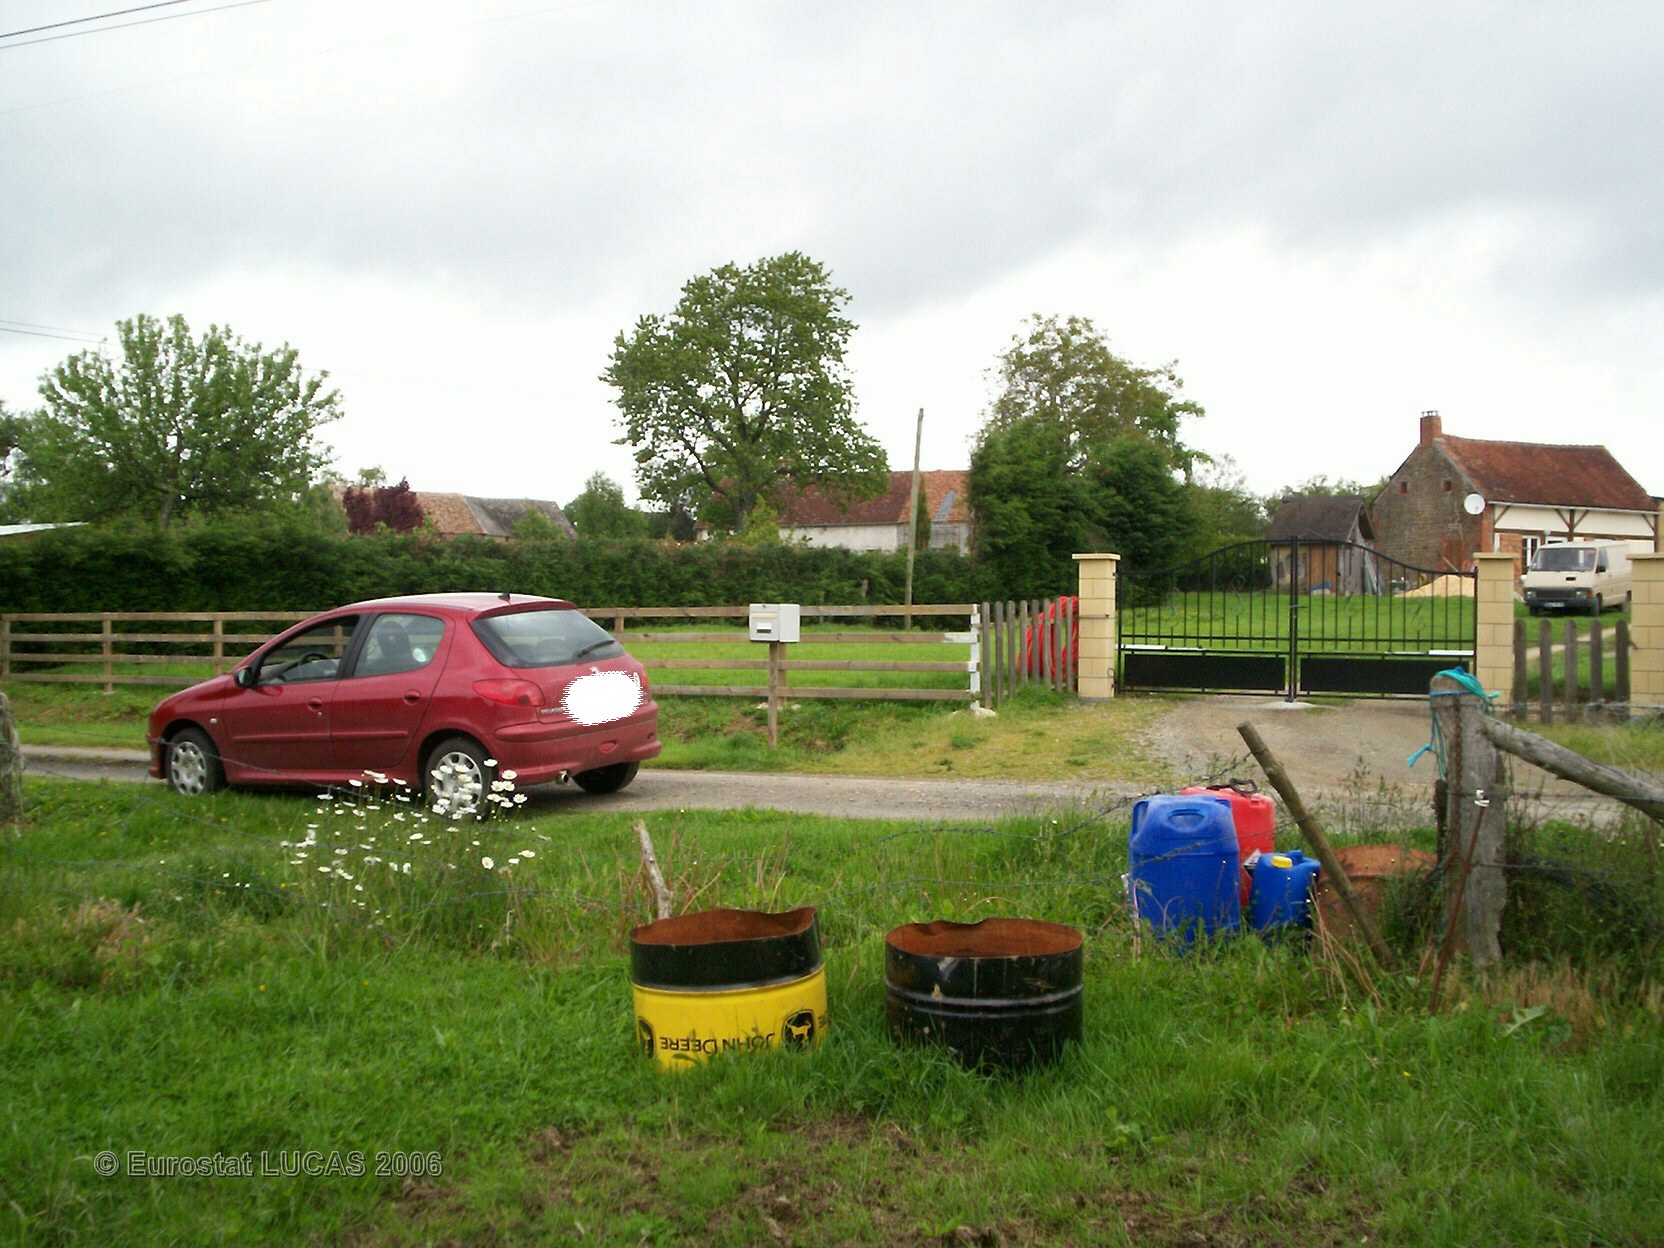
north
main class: Grassland
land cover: Grassland with sparse tree/shrub cover
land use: Agriculture (excluding fallow land and kitchen gardens)
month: May
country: FR
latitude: 48.6612
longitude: -0.3383
